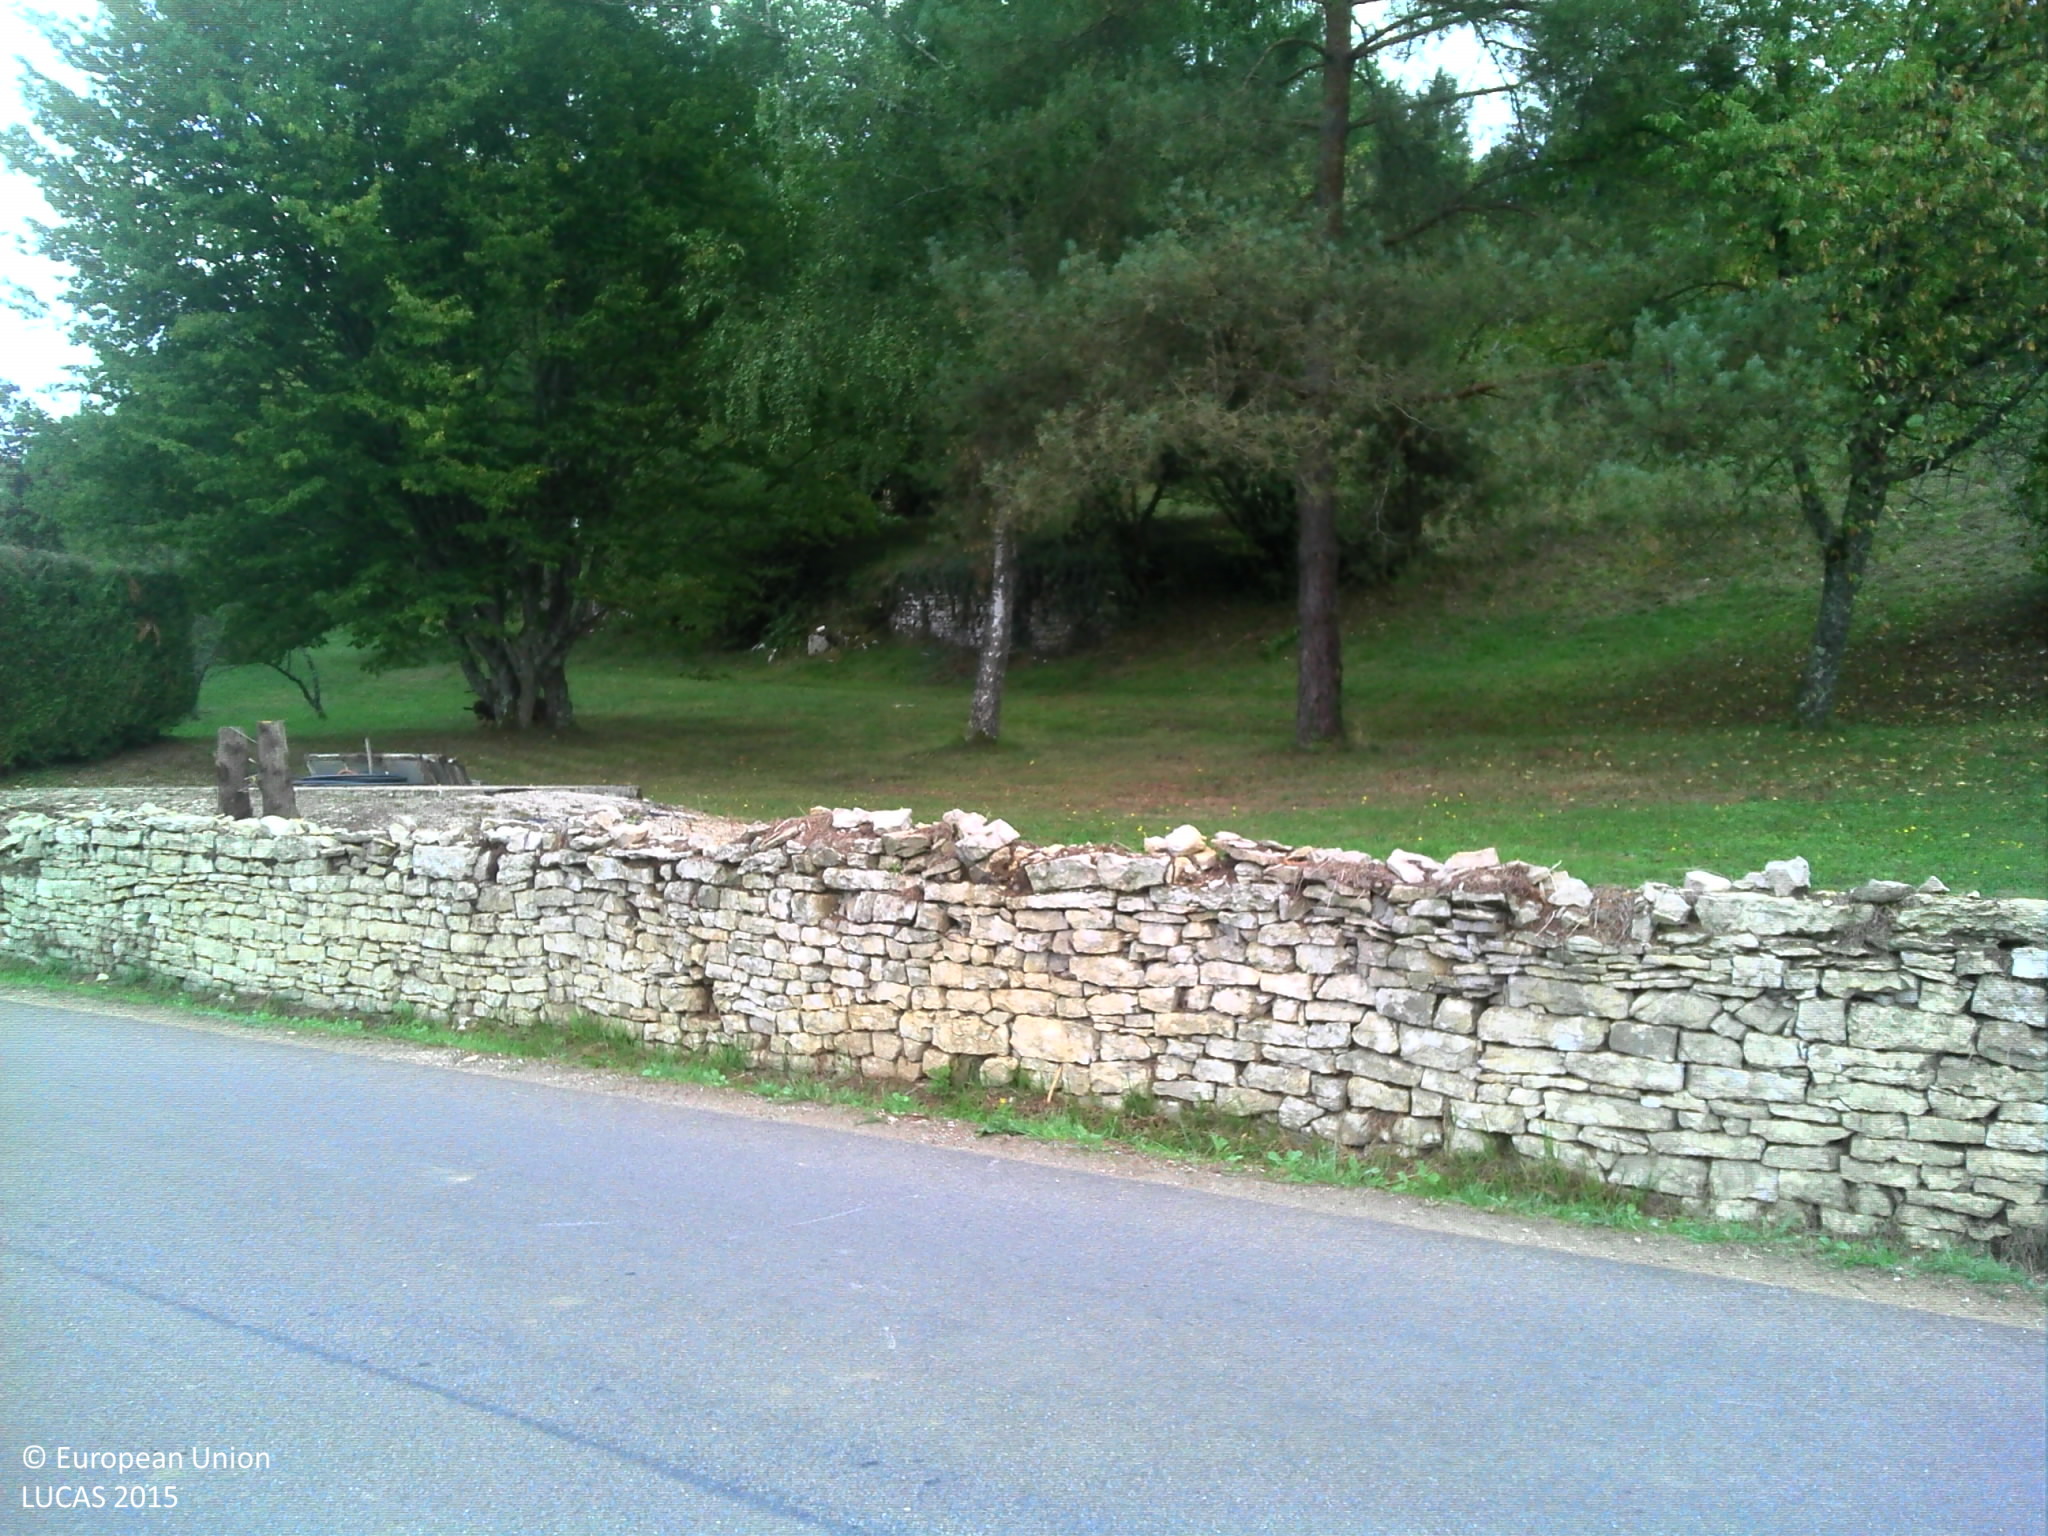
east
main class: Grassland
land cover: Grassland without tree/shrub cover
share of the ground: > 75 %
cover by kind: herbaceous plants 100 %
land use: Residential
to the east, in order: Grassland without tree/shrub cover; Fences; Managed hedges; Grassland without tree/shrub cover; Broadleaved woodland; Artificial constructions in urban areas; Broadleaved woodland; Paved roads, cycling and walking lanes; Broadleaved woodland; Shrubland with sparse tree cover; Broadleaved woodland
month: September
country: FR
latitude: 47.3824
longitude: 6.1736
